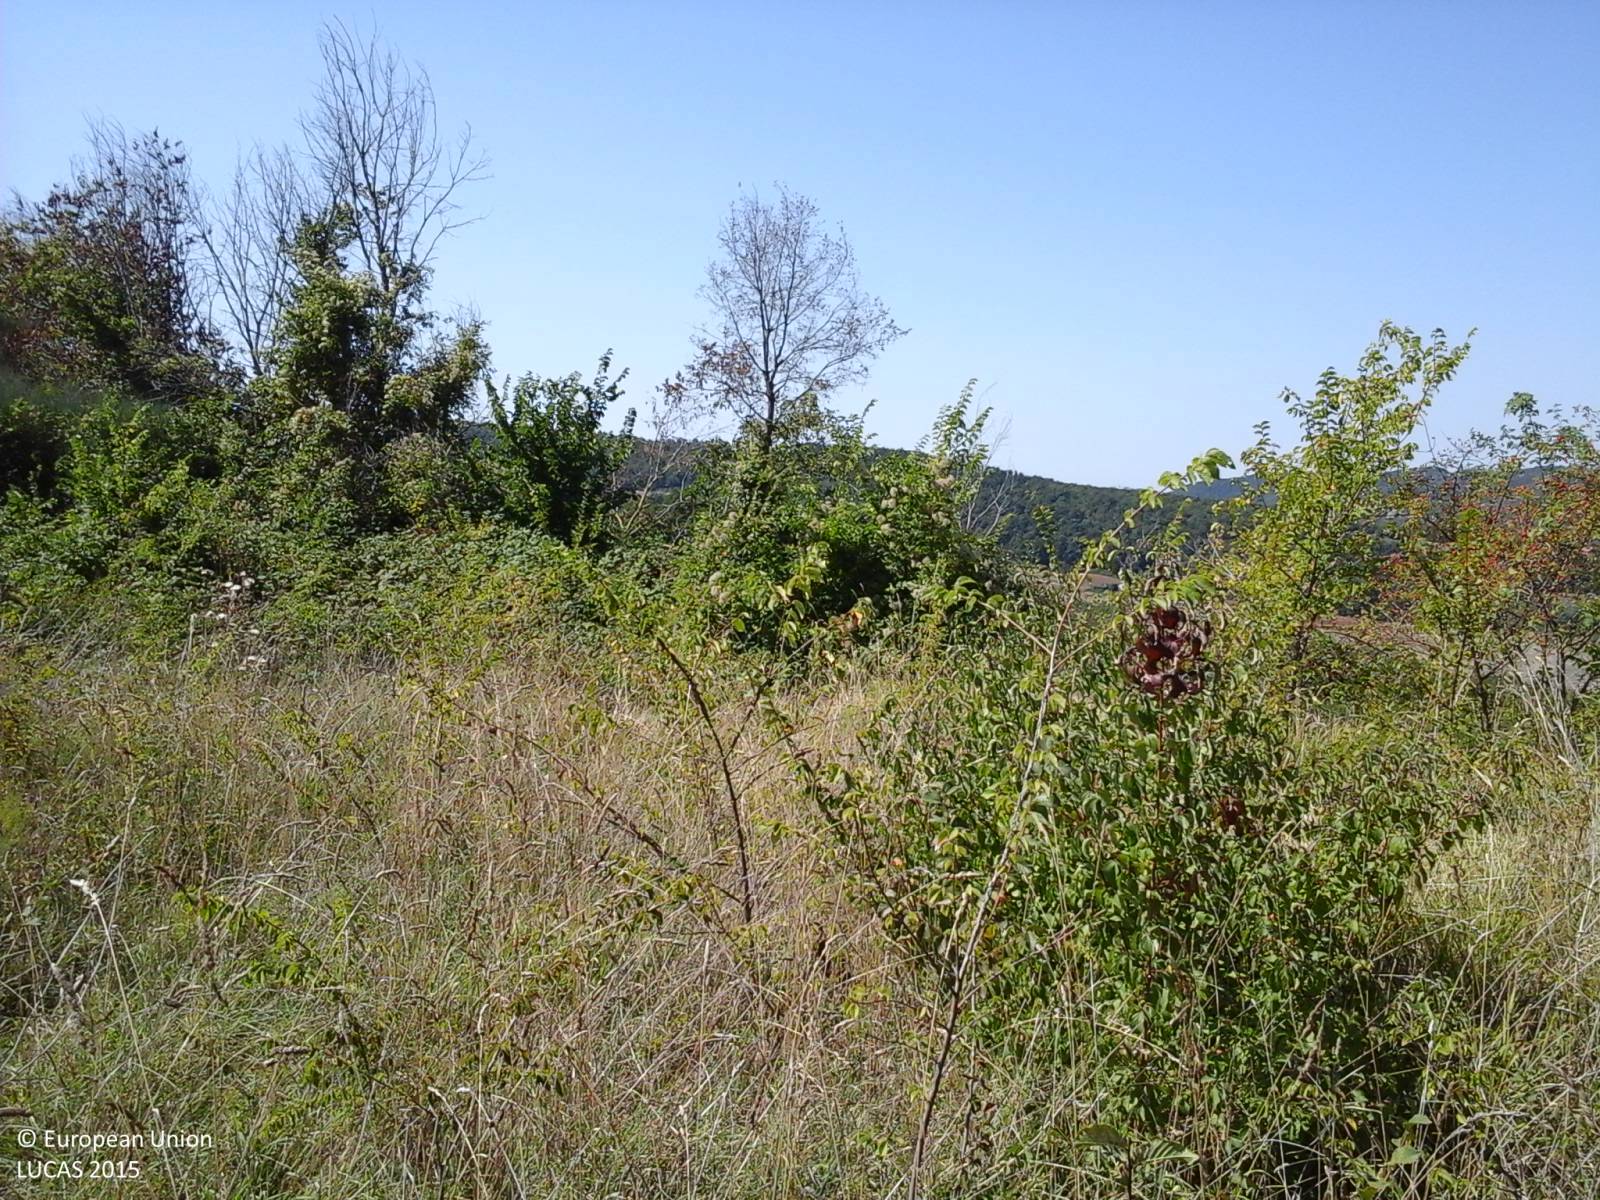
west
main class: Shrubland
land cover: Shrubland with sparse tree cover
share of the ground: 50 - 75 %
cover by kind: shrubs 55 %, herbaceous plants 40 %, broadleaved forest trees 5 %
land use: Abandoned areas
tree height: < 5 m
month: September
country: IT
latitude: 43.1256
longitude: 12.6352
